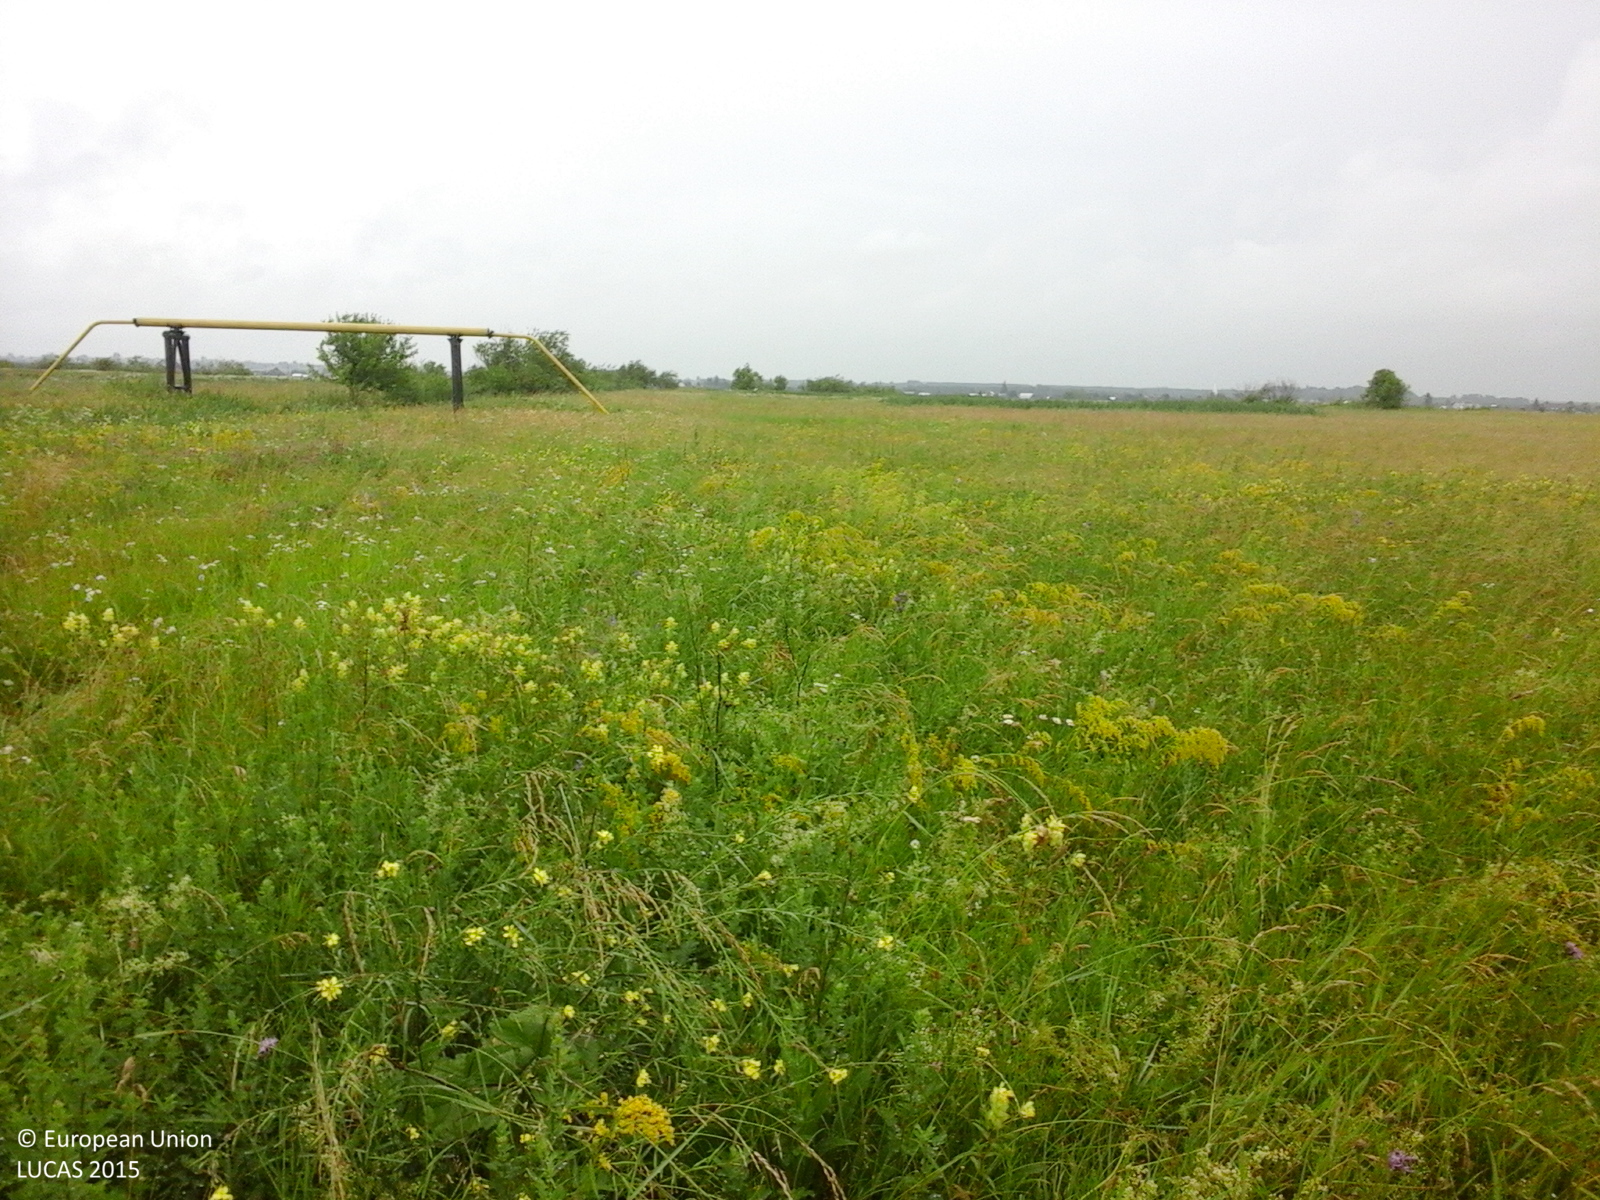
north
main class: Grassland
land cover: Spontaneously vegetated surfaces
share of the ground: > 75 %
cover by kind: herbaceous plants 100 %
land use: Fallow land
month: June
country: RO
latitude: 47.8818
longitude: 25.9218
